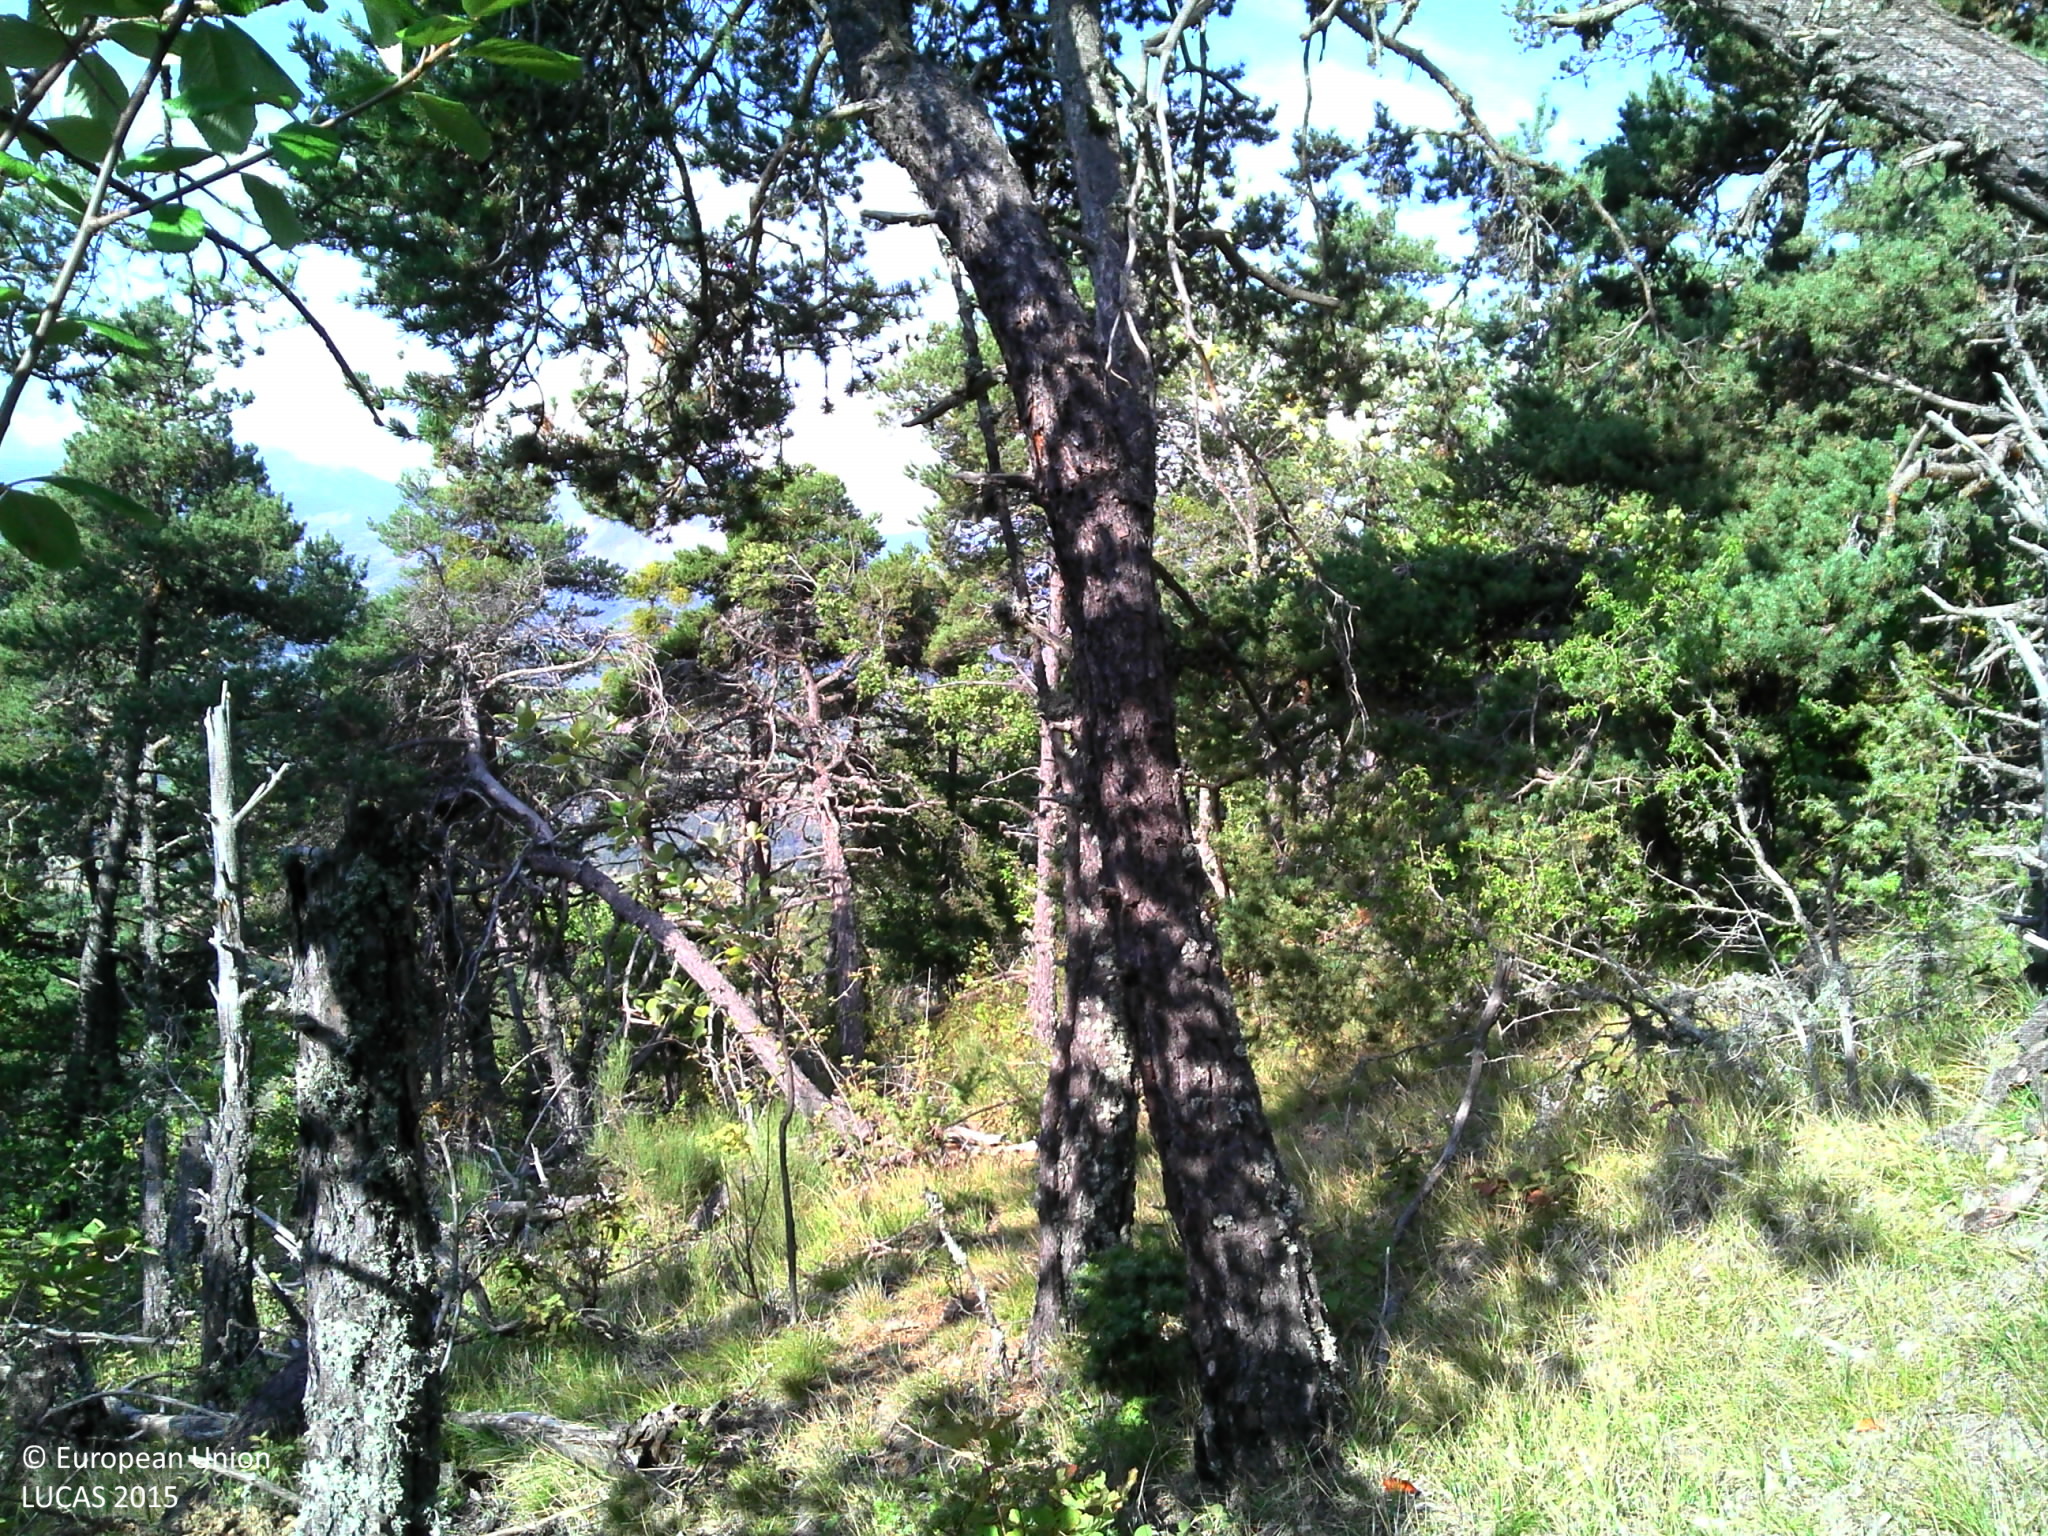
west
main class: Woodland
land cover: Pine dominated coniferous woodland
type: alpine coniferous forest
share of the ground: > 75 %
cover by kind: coniferous forest trees 50 %, herbaceous plants 20 %, broadleaved forest trees 10 %, shrubs 10 %, unconsolidated bare surface 10 %
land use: Semi-natural and natural areas not in use
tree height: > 5 m
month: September
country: FR
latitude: 44.4084
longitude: 6.2271
